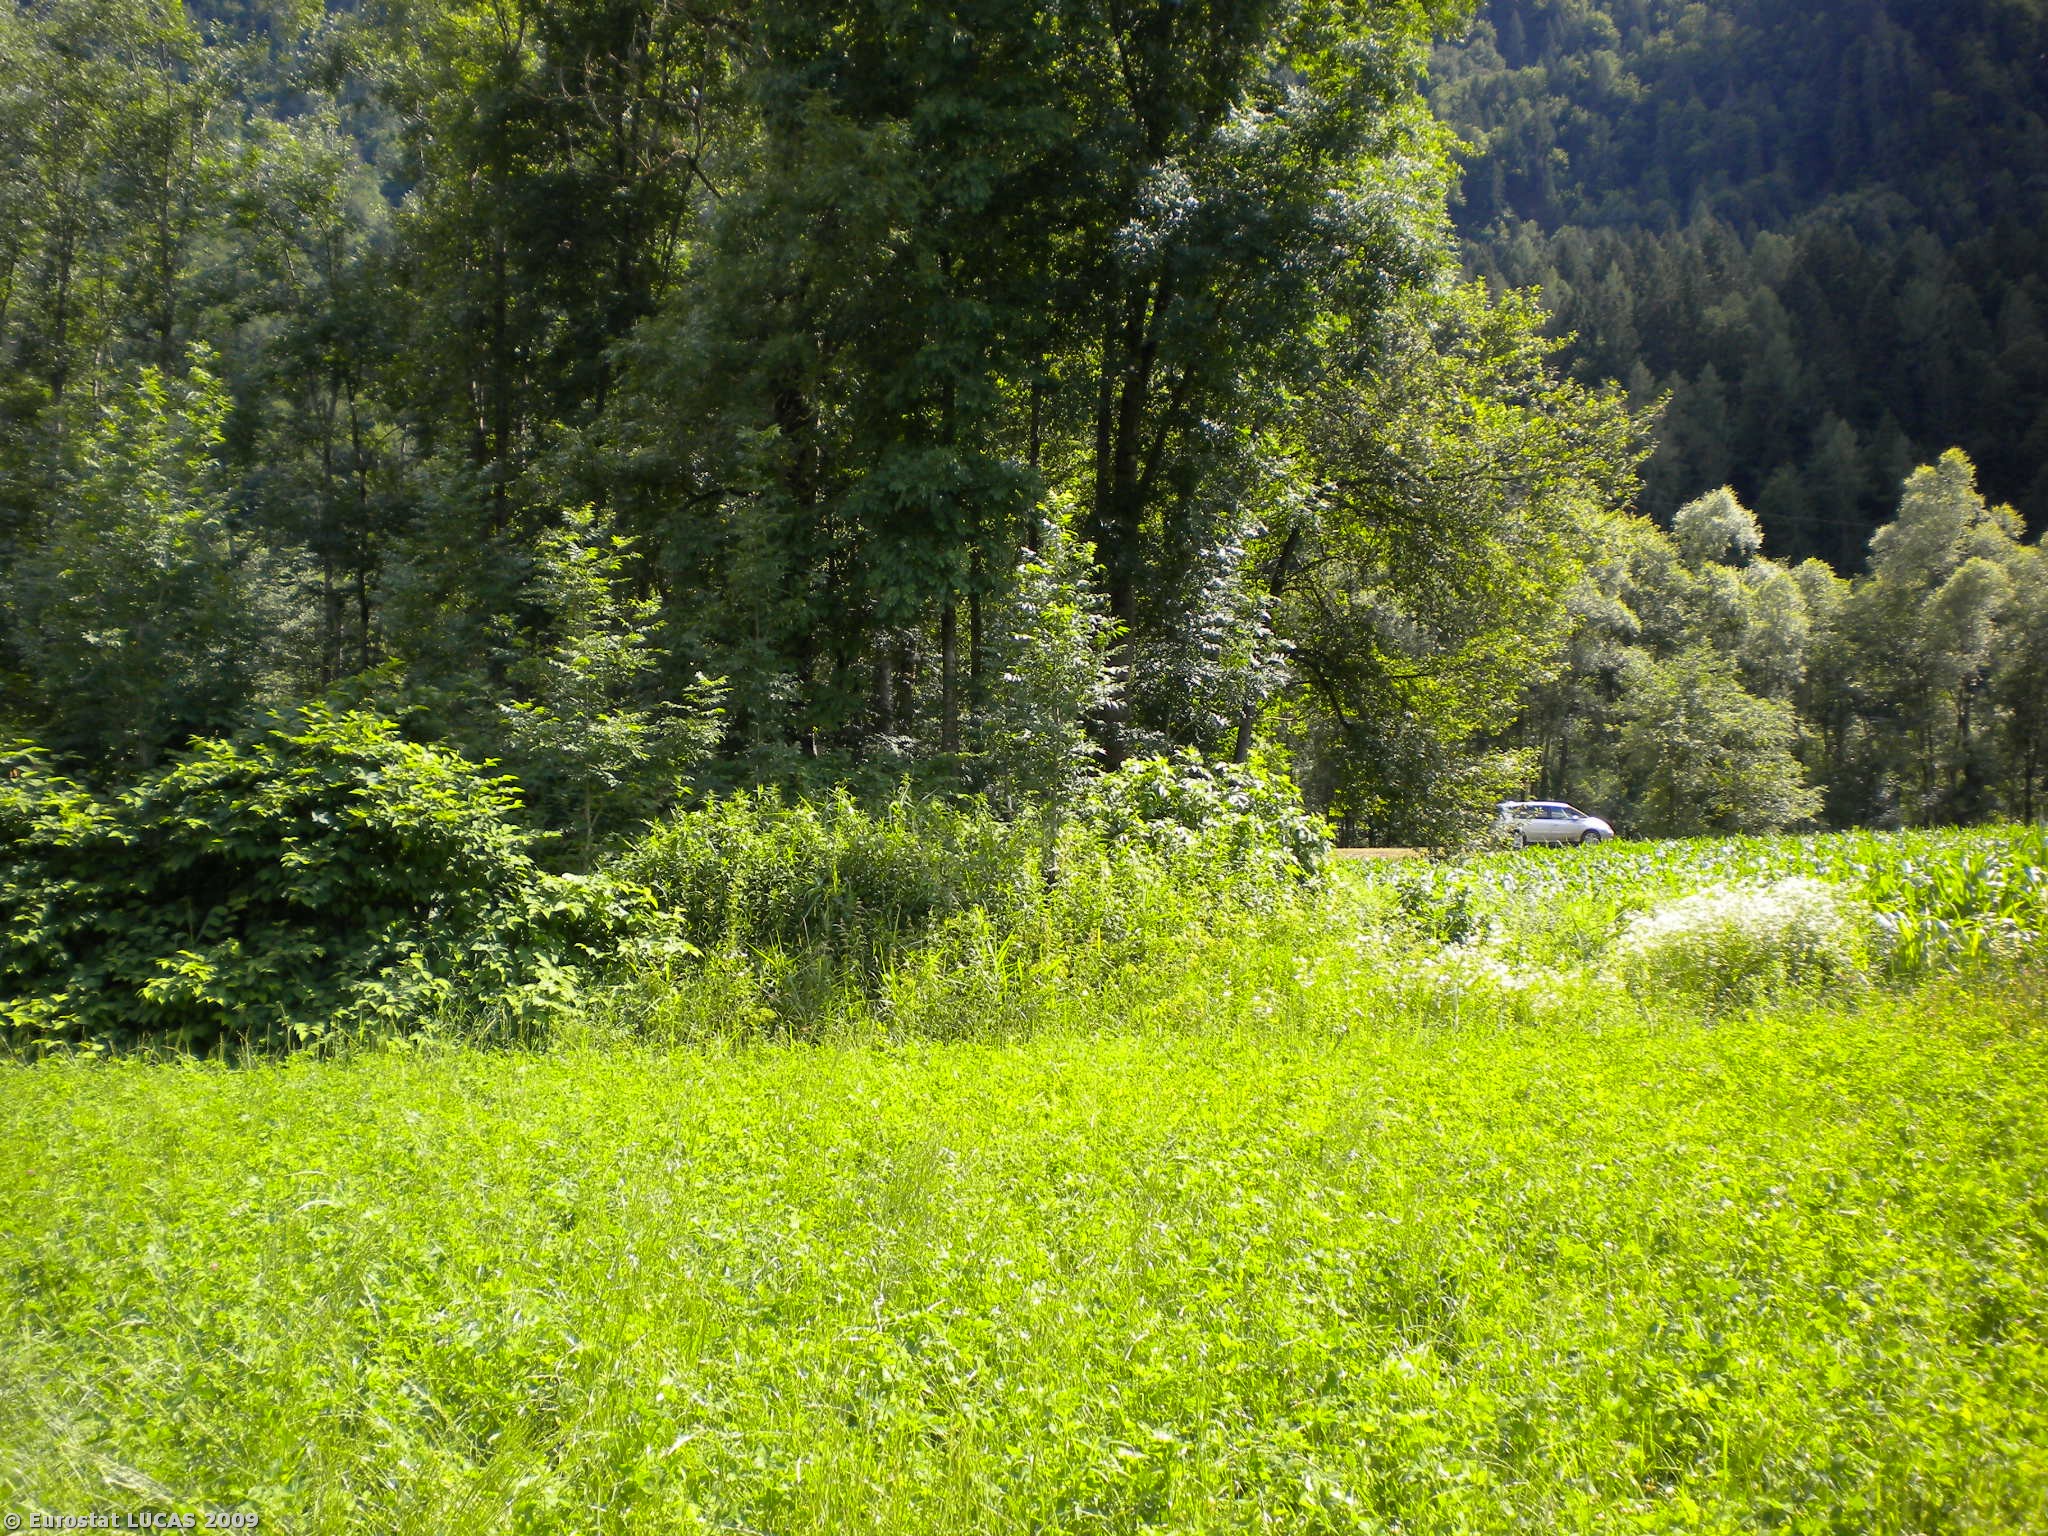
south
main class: Grassland
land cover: Grassland without tree/shrub cover
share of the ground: > 75 %
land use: Agriculture (excluding fallow land and kitchen gardens)
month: July
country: AT
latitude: 46.6027
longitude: 13.4306
